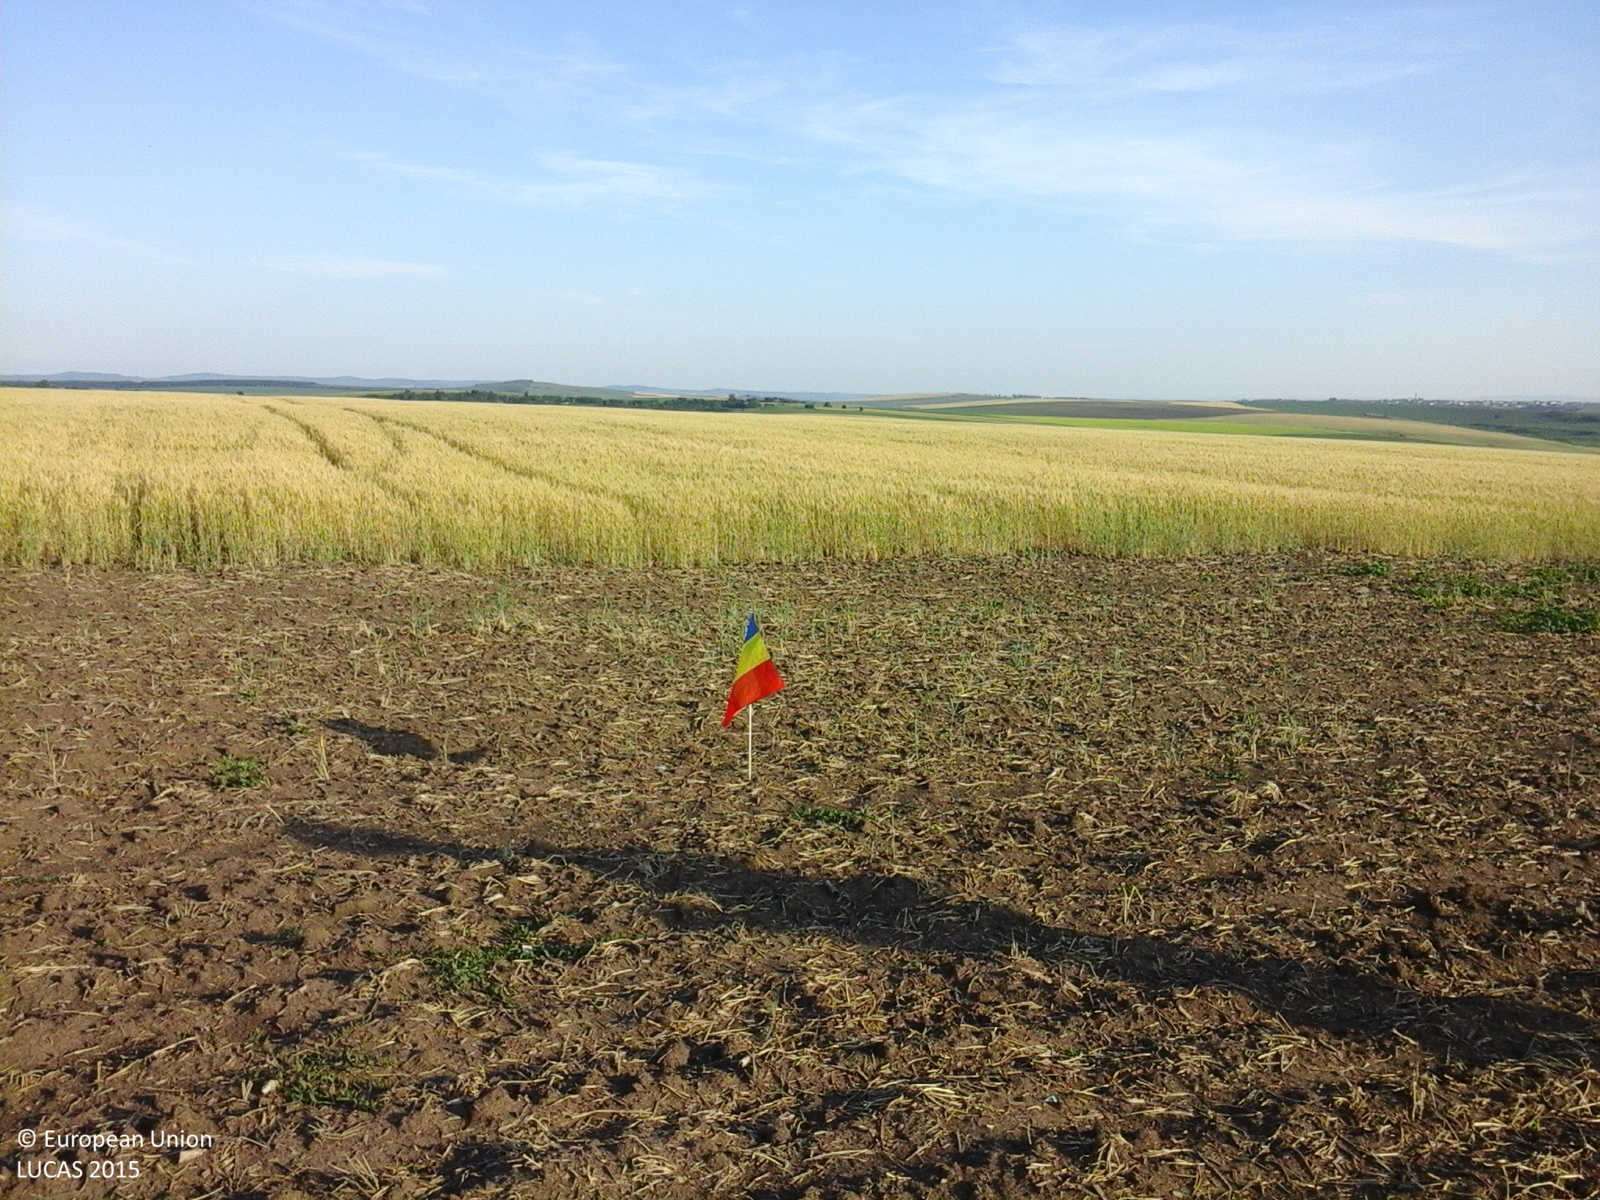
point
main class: Cropland
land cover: Common wheat
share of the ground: < 10 %
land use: Agriculture (excluding fallow land and kitchen gardens)
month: June
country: RO
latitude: 47.0961
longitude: 26.9765
